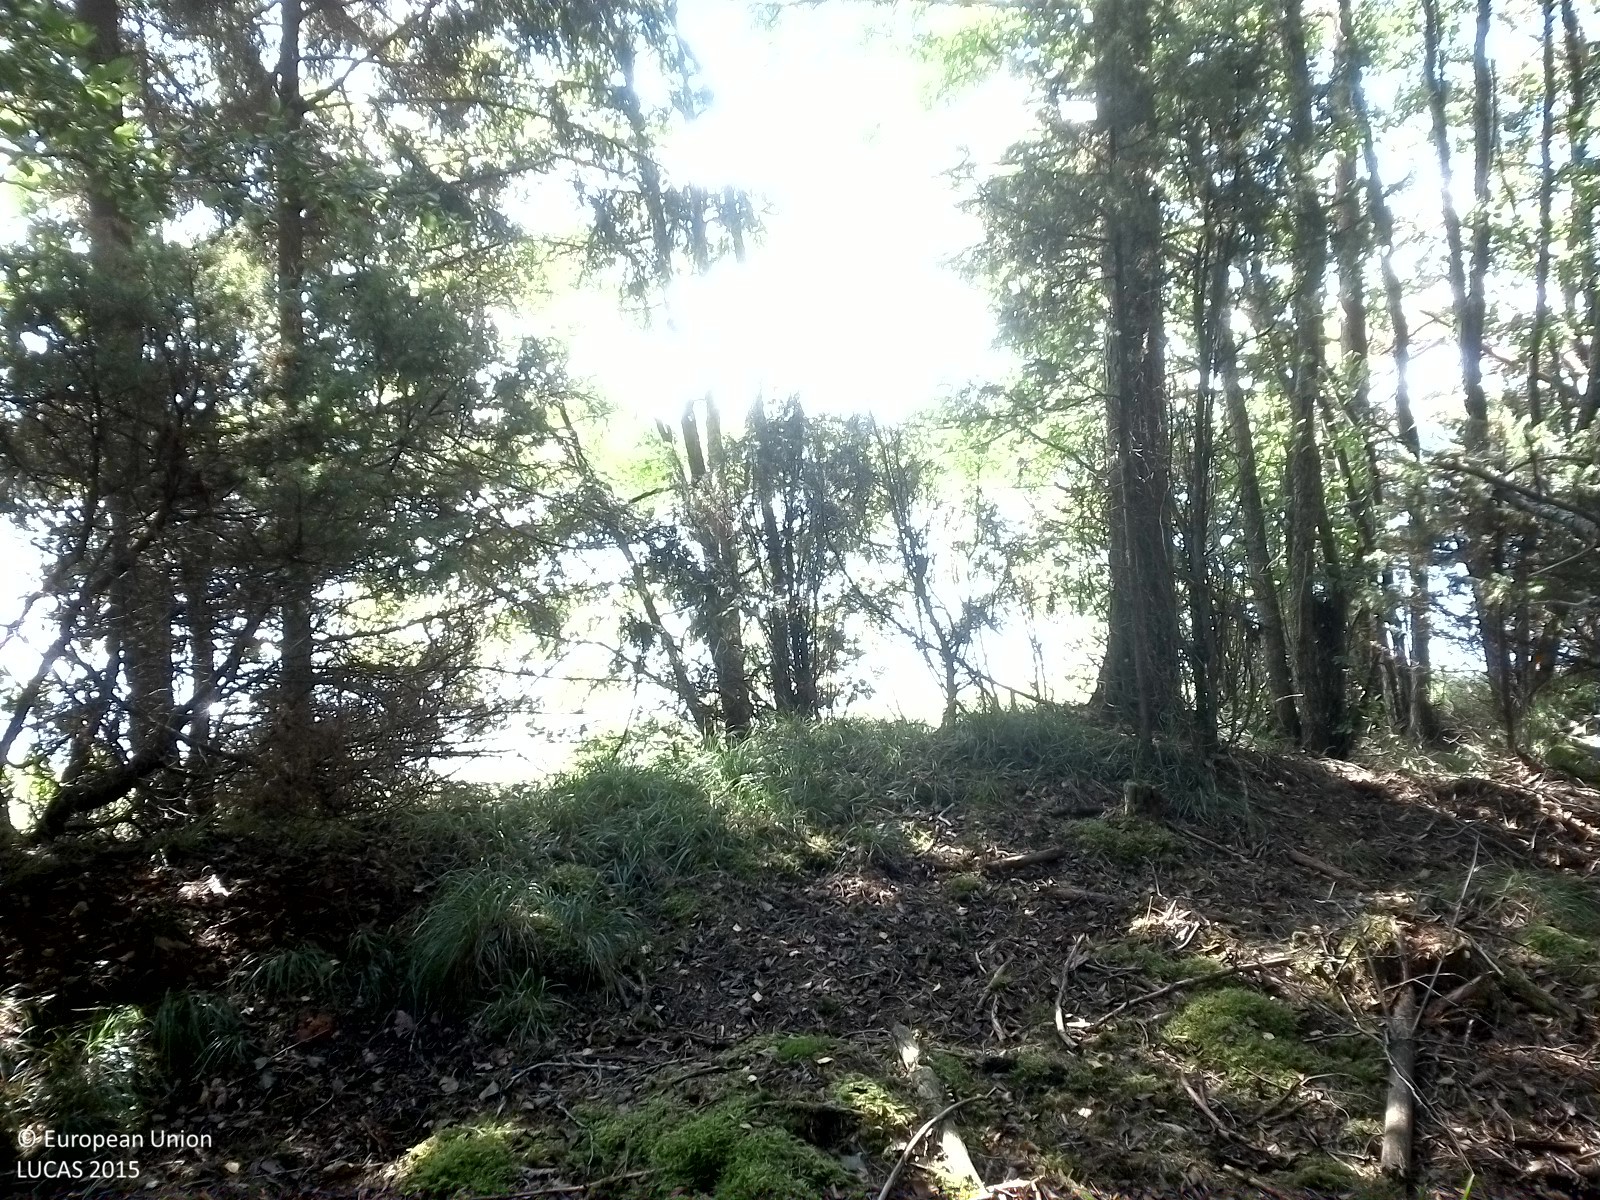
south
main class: Woodland
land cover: Spruce dominated coniferous woodland
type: boreal forest
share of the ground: 50 - 75 %
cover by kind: coniferous forest trees 70 %, herbaceous plants 10 %, lichens and mosses 10 %, unconsolidated bare surface 10 %
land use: Forestry
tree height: > 5 m
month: August
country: SE
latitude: 58.9489
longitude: 15.6420
